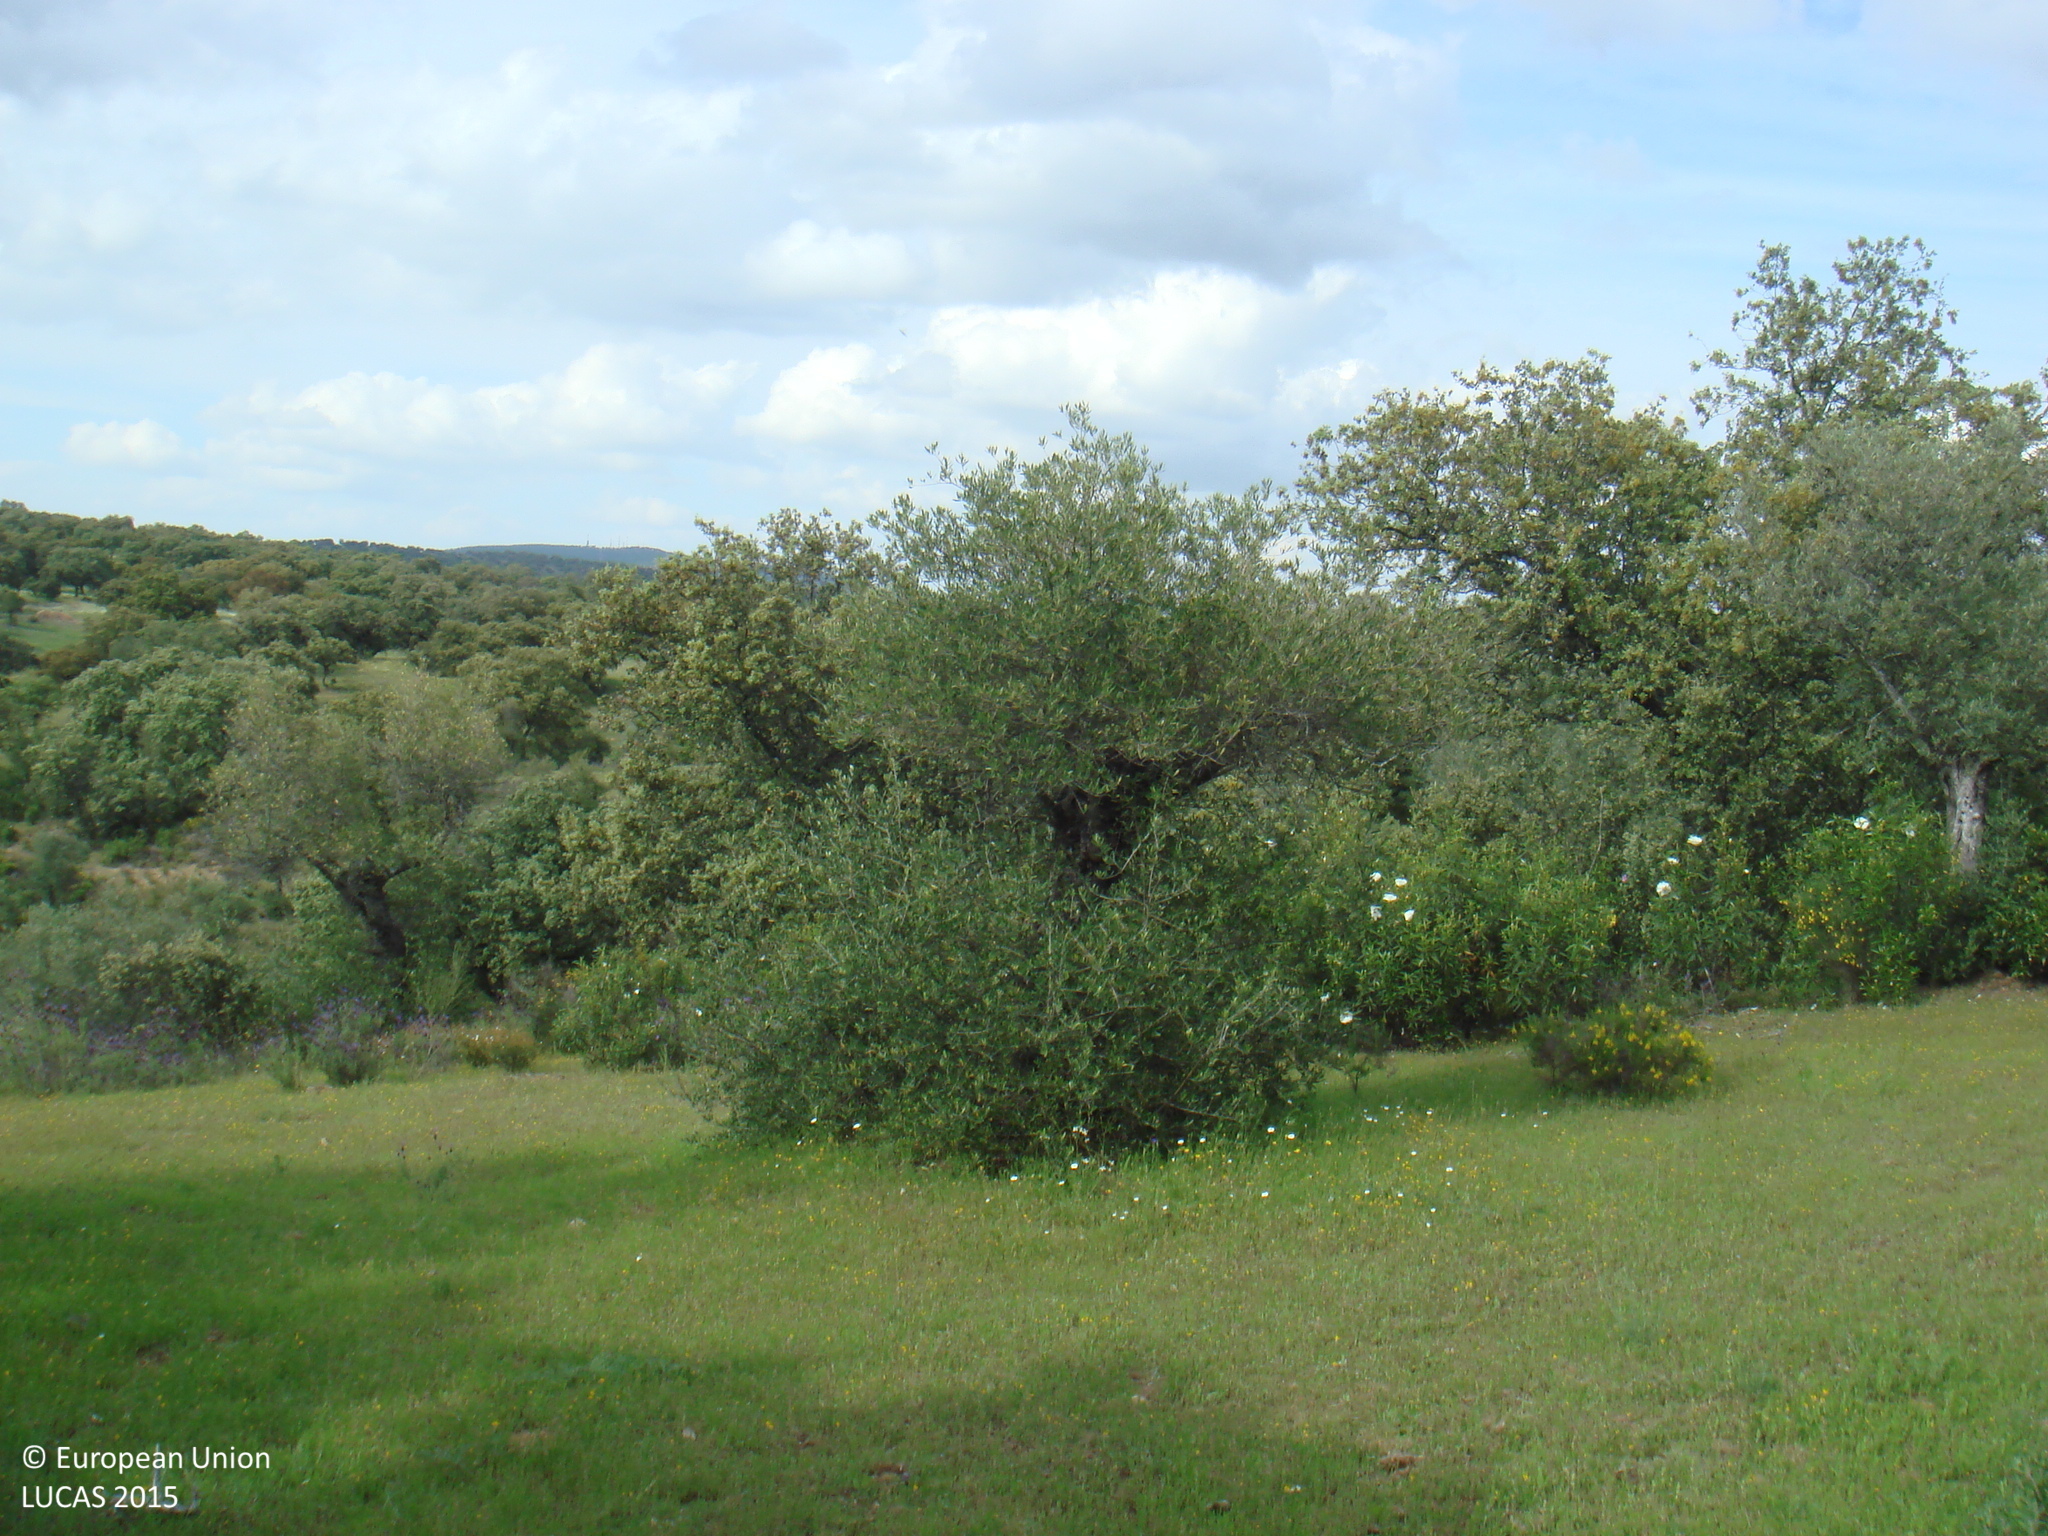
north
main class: Cropland
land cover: Olive groves
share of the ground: 10 - 25 %
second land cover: Grassland without tree/shrub cover
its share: > 75 %
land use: Agriculture (excluding fallow land and kitchen gardens)
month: April
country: ES
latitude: 38.2036
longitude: -5.0170
